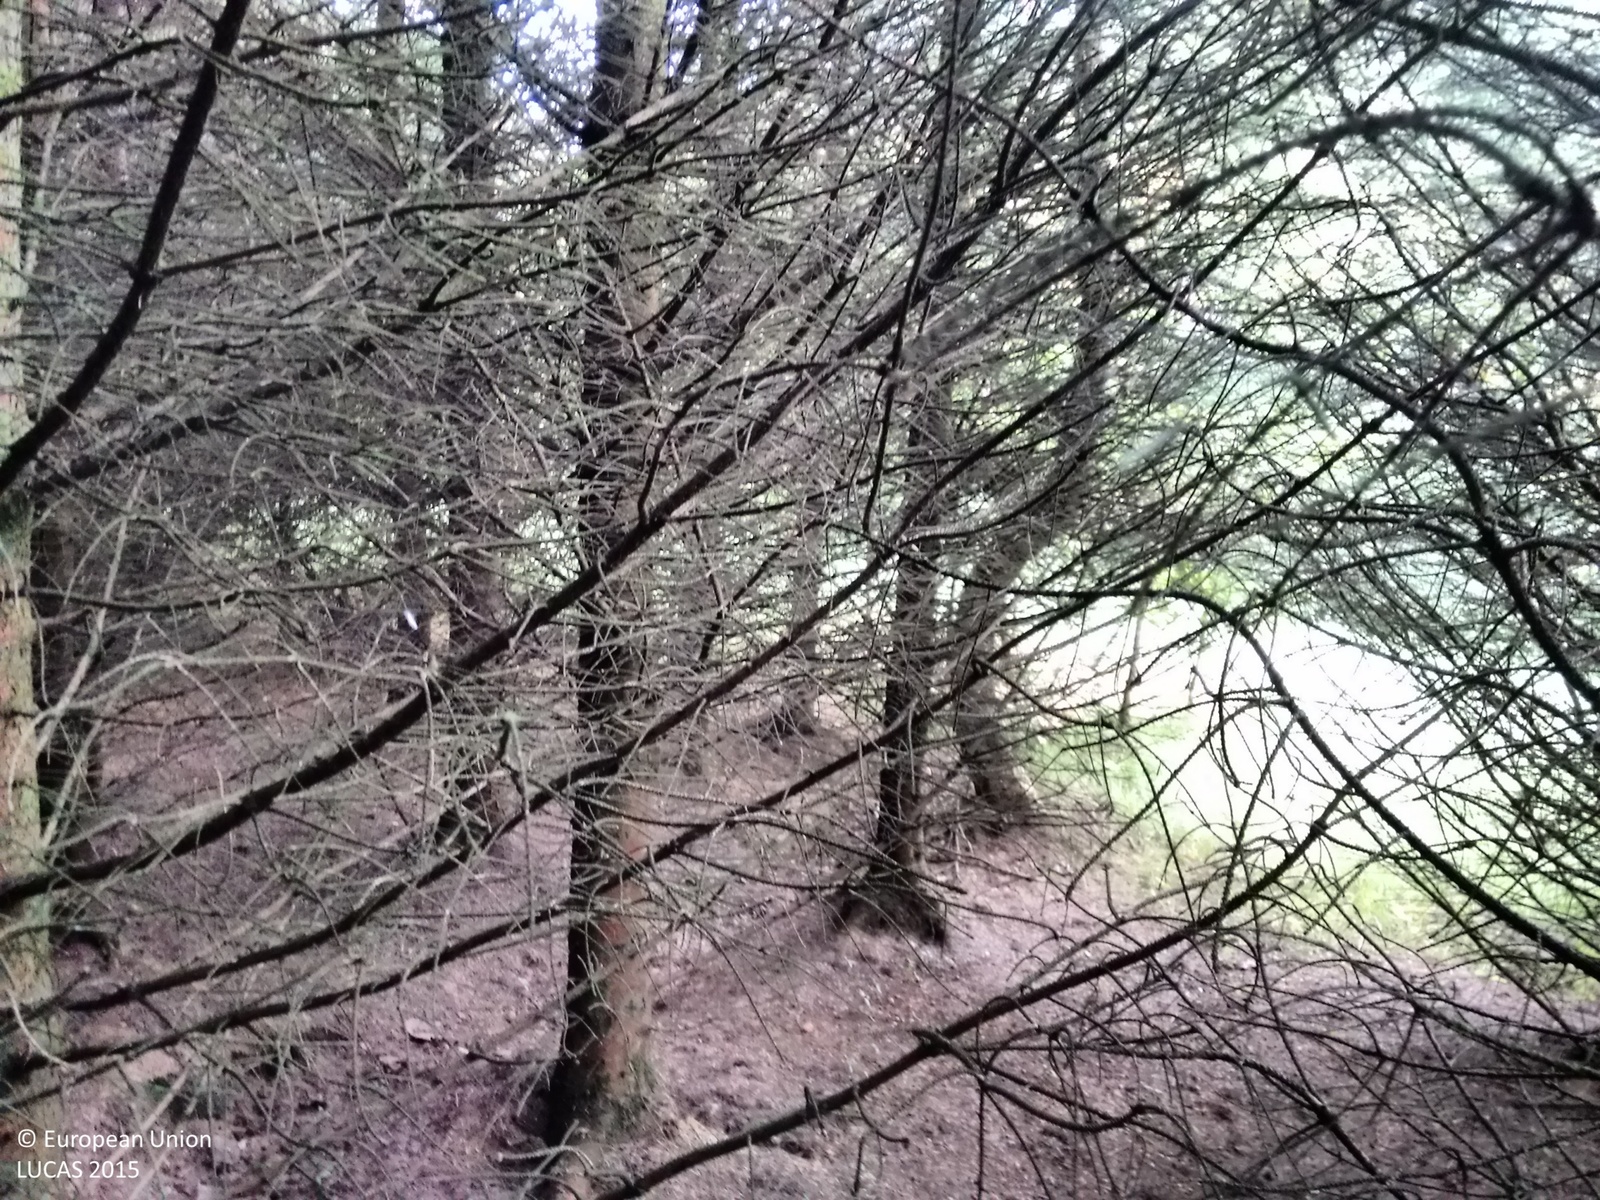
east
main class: Woodland
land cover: Spruce dominated coniferous woodland
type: exotic forest
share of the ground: > 75 %
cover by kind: coniferous forest trees 100 %
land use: Forestry
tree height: > 5 m
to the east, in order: Spruce dominated coniferous woodland; Grassland without tree/shrub cover; Fences; Broadleaved woodland; Inland fresh running water; Broadleaved woodland; Electric lines; Grassland without tree/shrub cover; Fences; Broadleaved woodland; Inland fresh running water; Broadleaved woodland; Grassland without tree/shrub cover; Fences; Grassland without tree/shrub cover
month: September
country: IE
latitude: 55.0210
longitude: -7.4030
